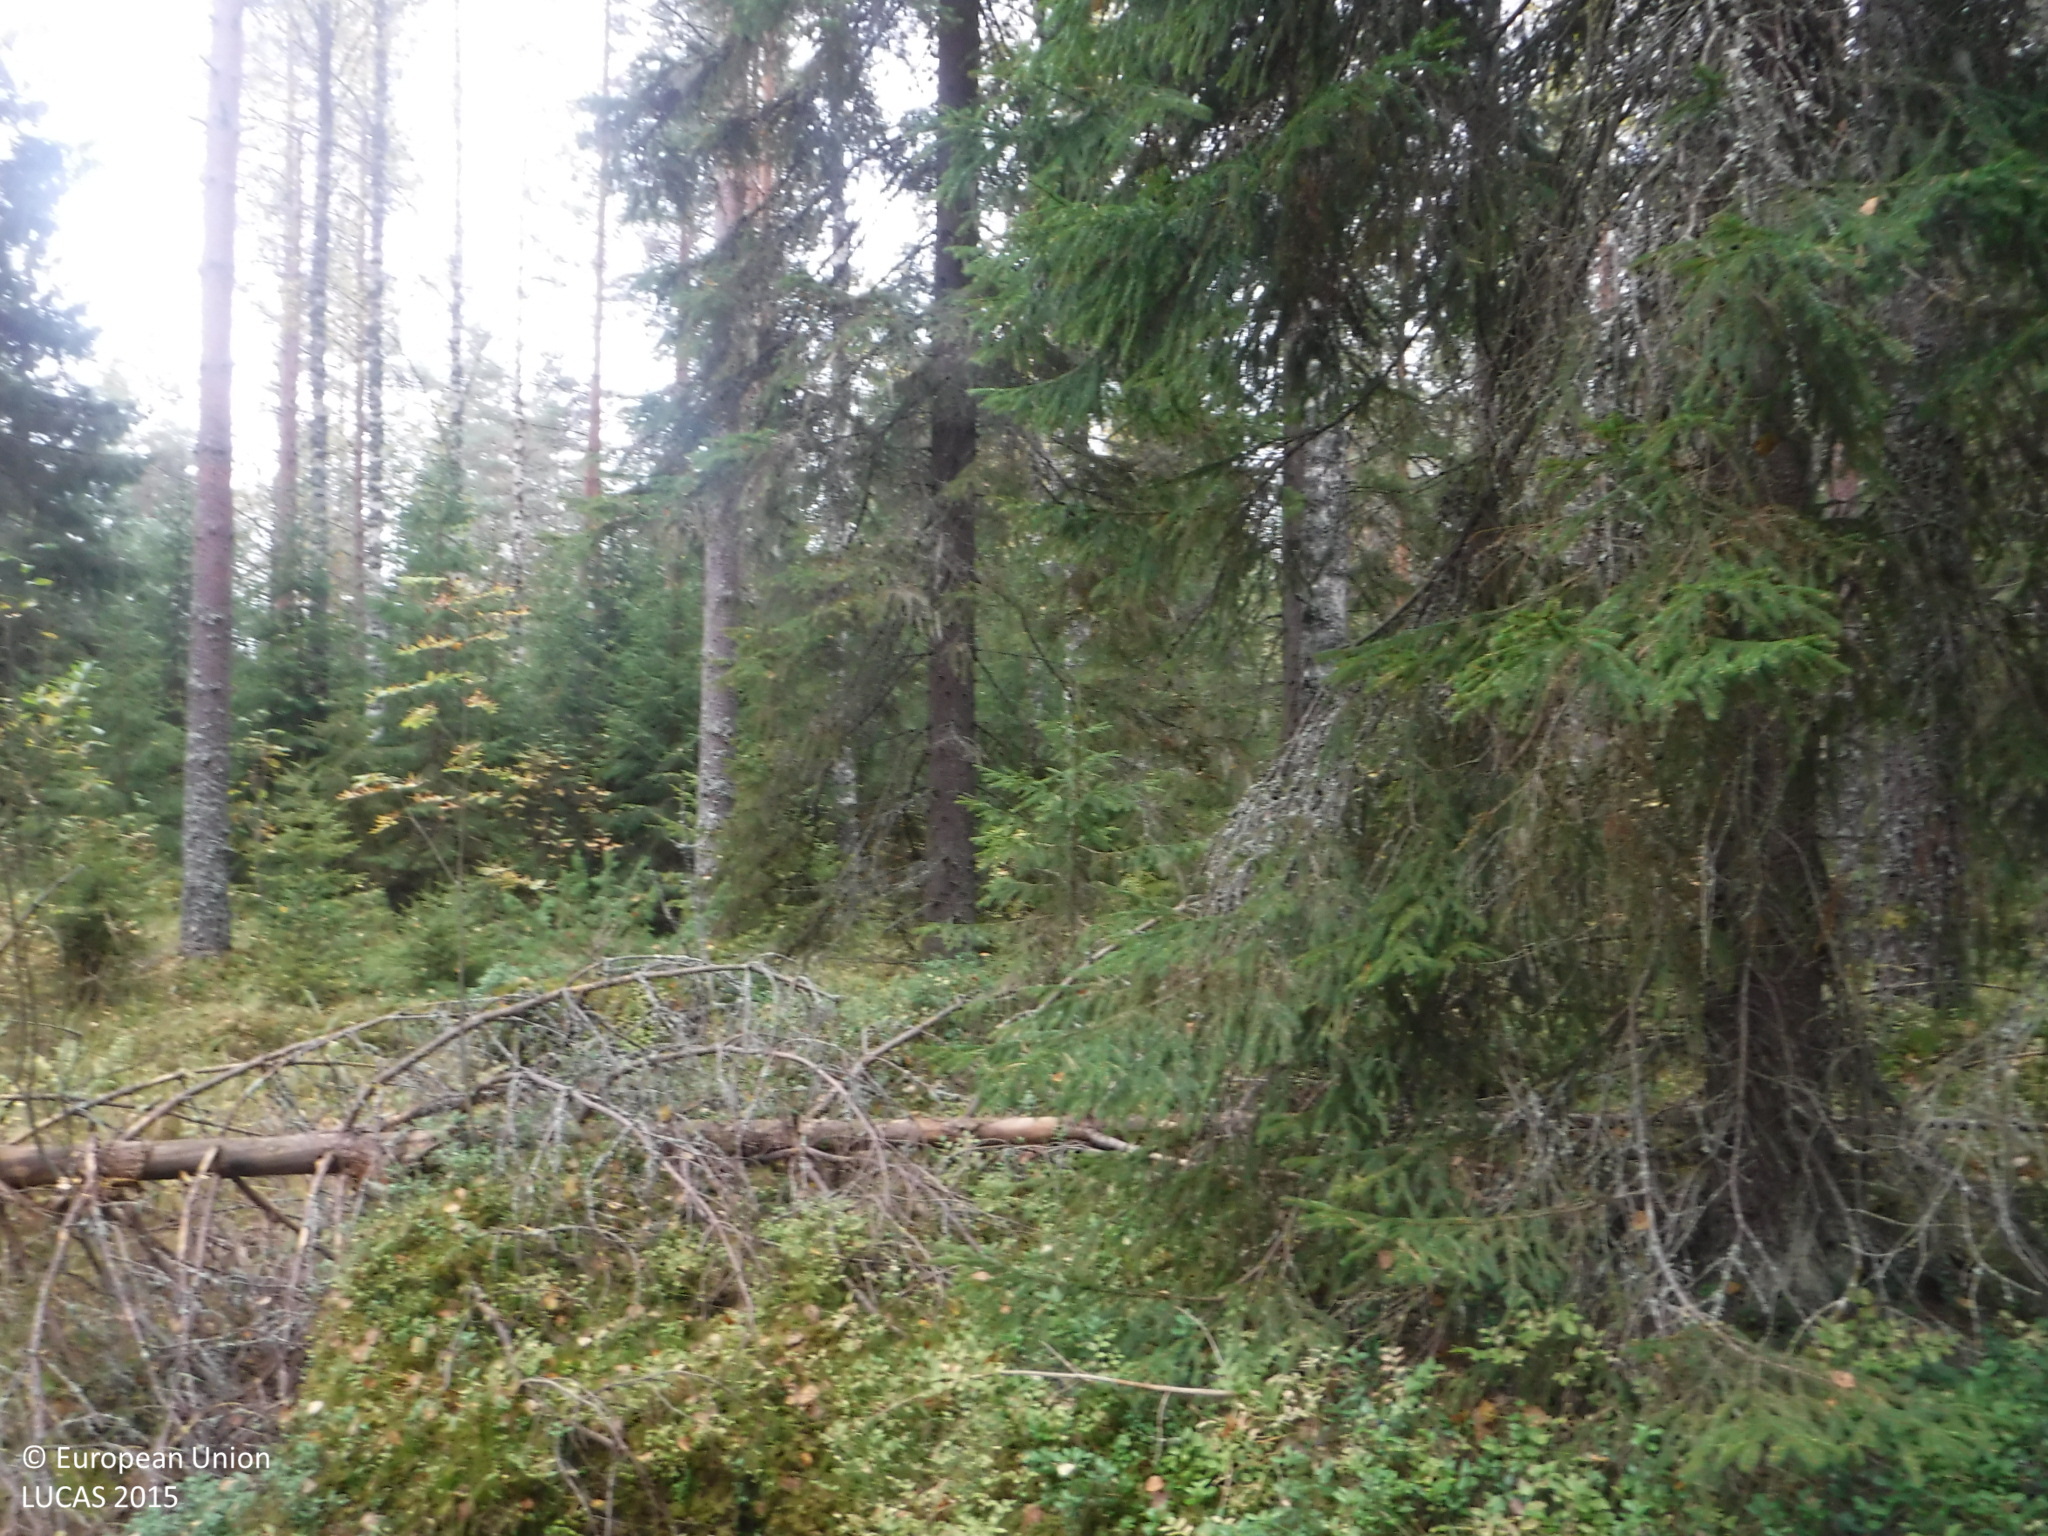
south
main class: Woodland
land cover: Other coniferous woodland
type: boreal forest
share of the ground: 50 - 75 %
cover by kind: coniferous forest trees 55 %, lichens and mosses 20 %, shrubs 15 %, broadleaved forest trees 10 %
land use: Forestry
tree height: > 5 m
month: September
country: FI
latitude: 61.7756
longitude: 24.1342
